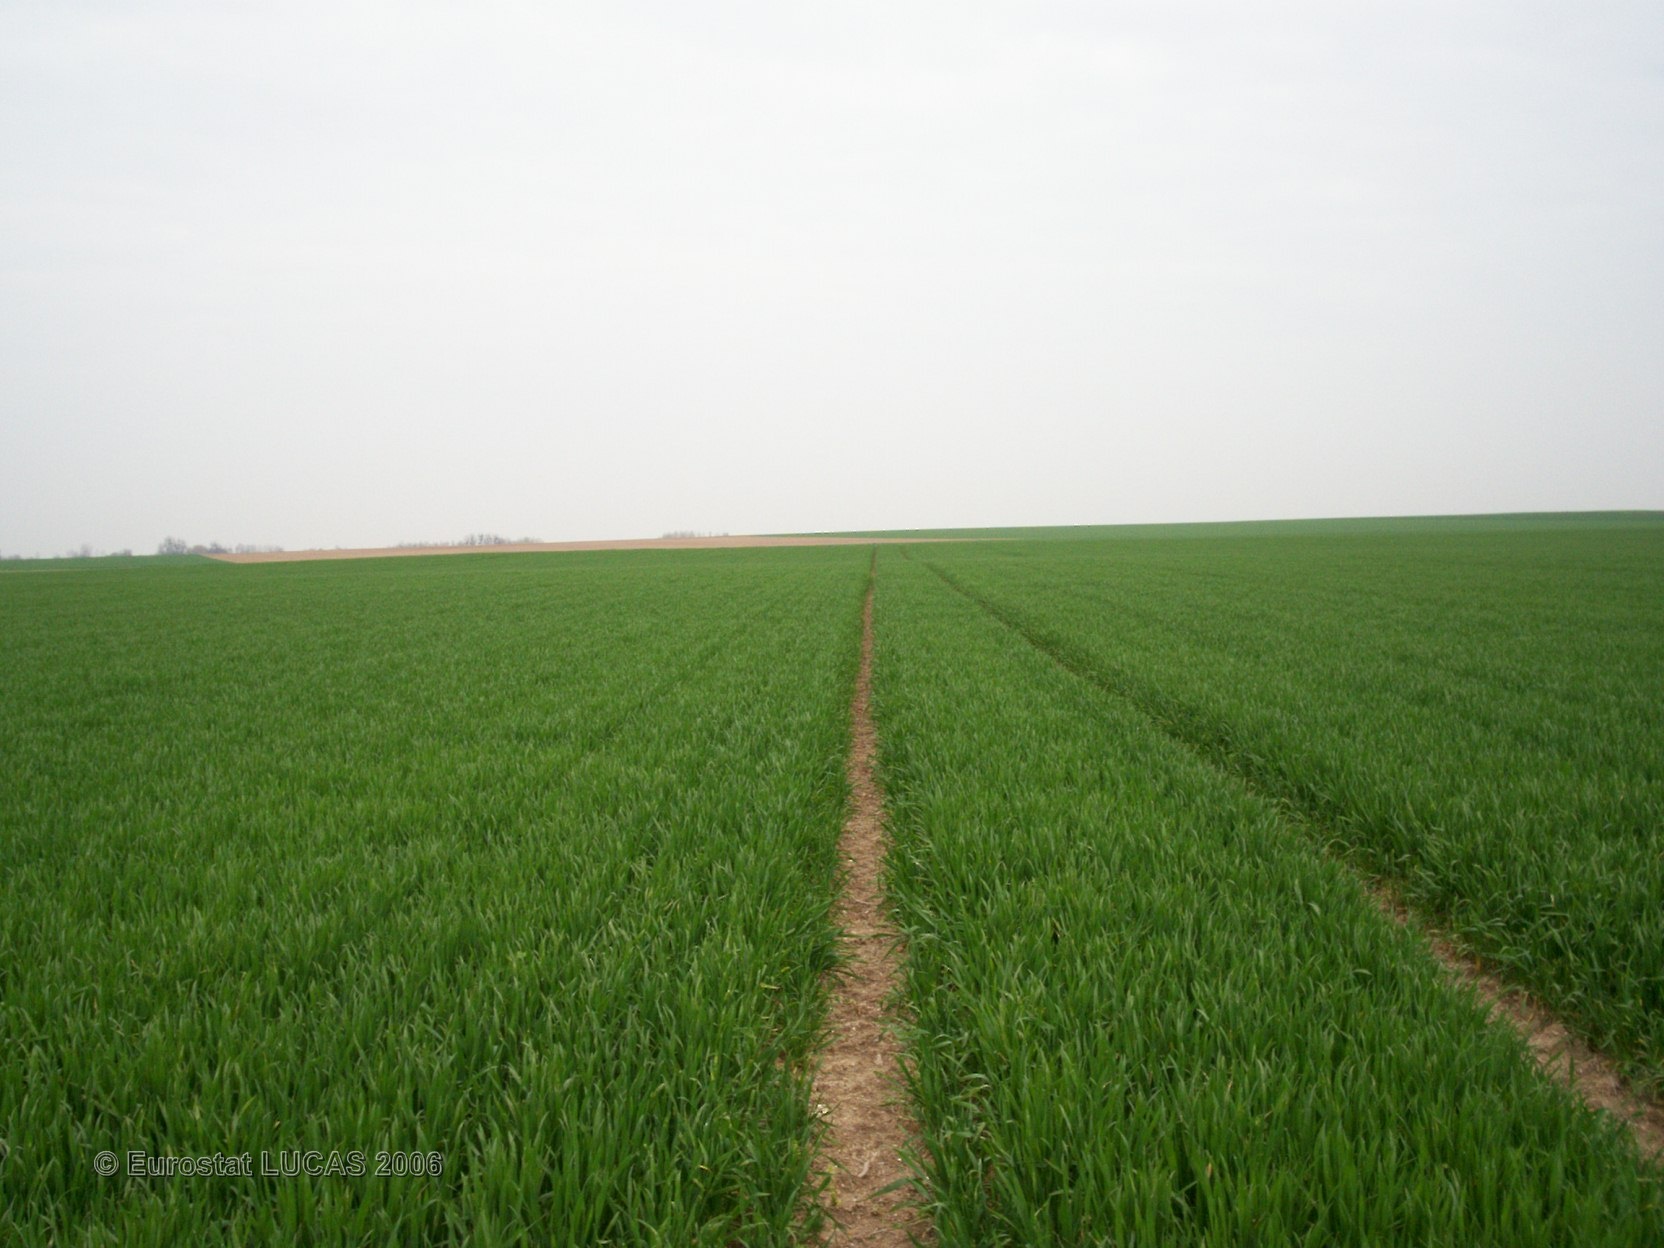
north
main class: Cropland
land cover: Common wheat
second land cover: Lucerne
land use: Agriculture (excluding fallow land and kitchen gardens)
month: April
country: FR
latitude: 48.6531
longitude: 3.9547
